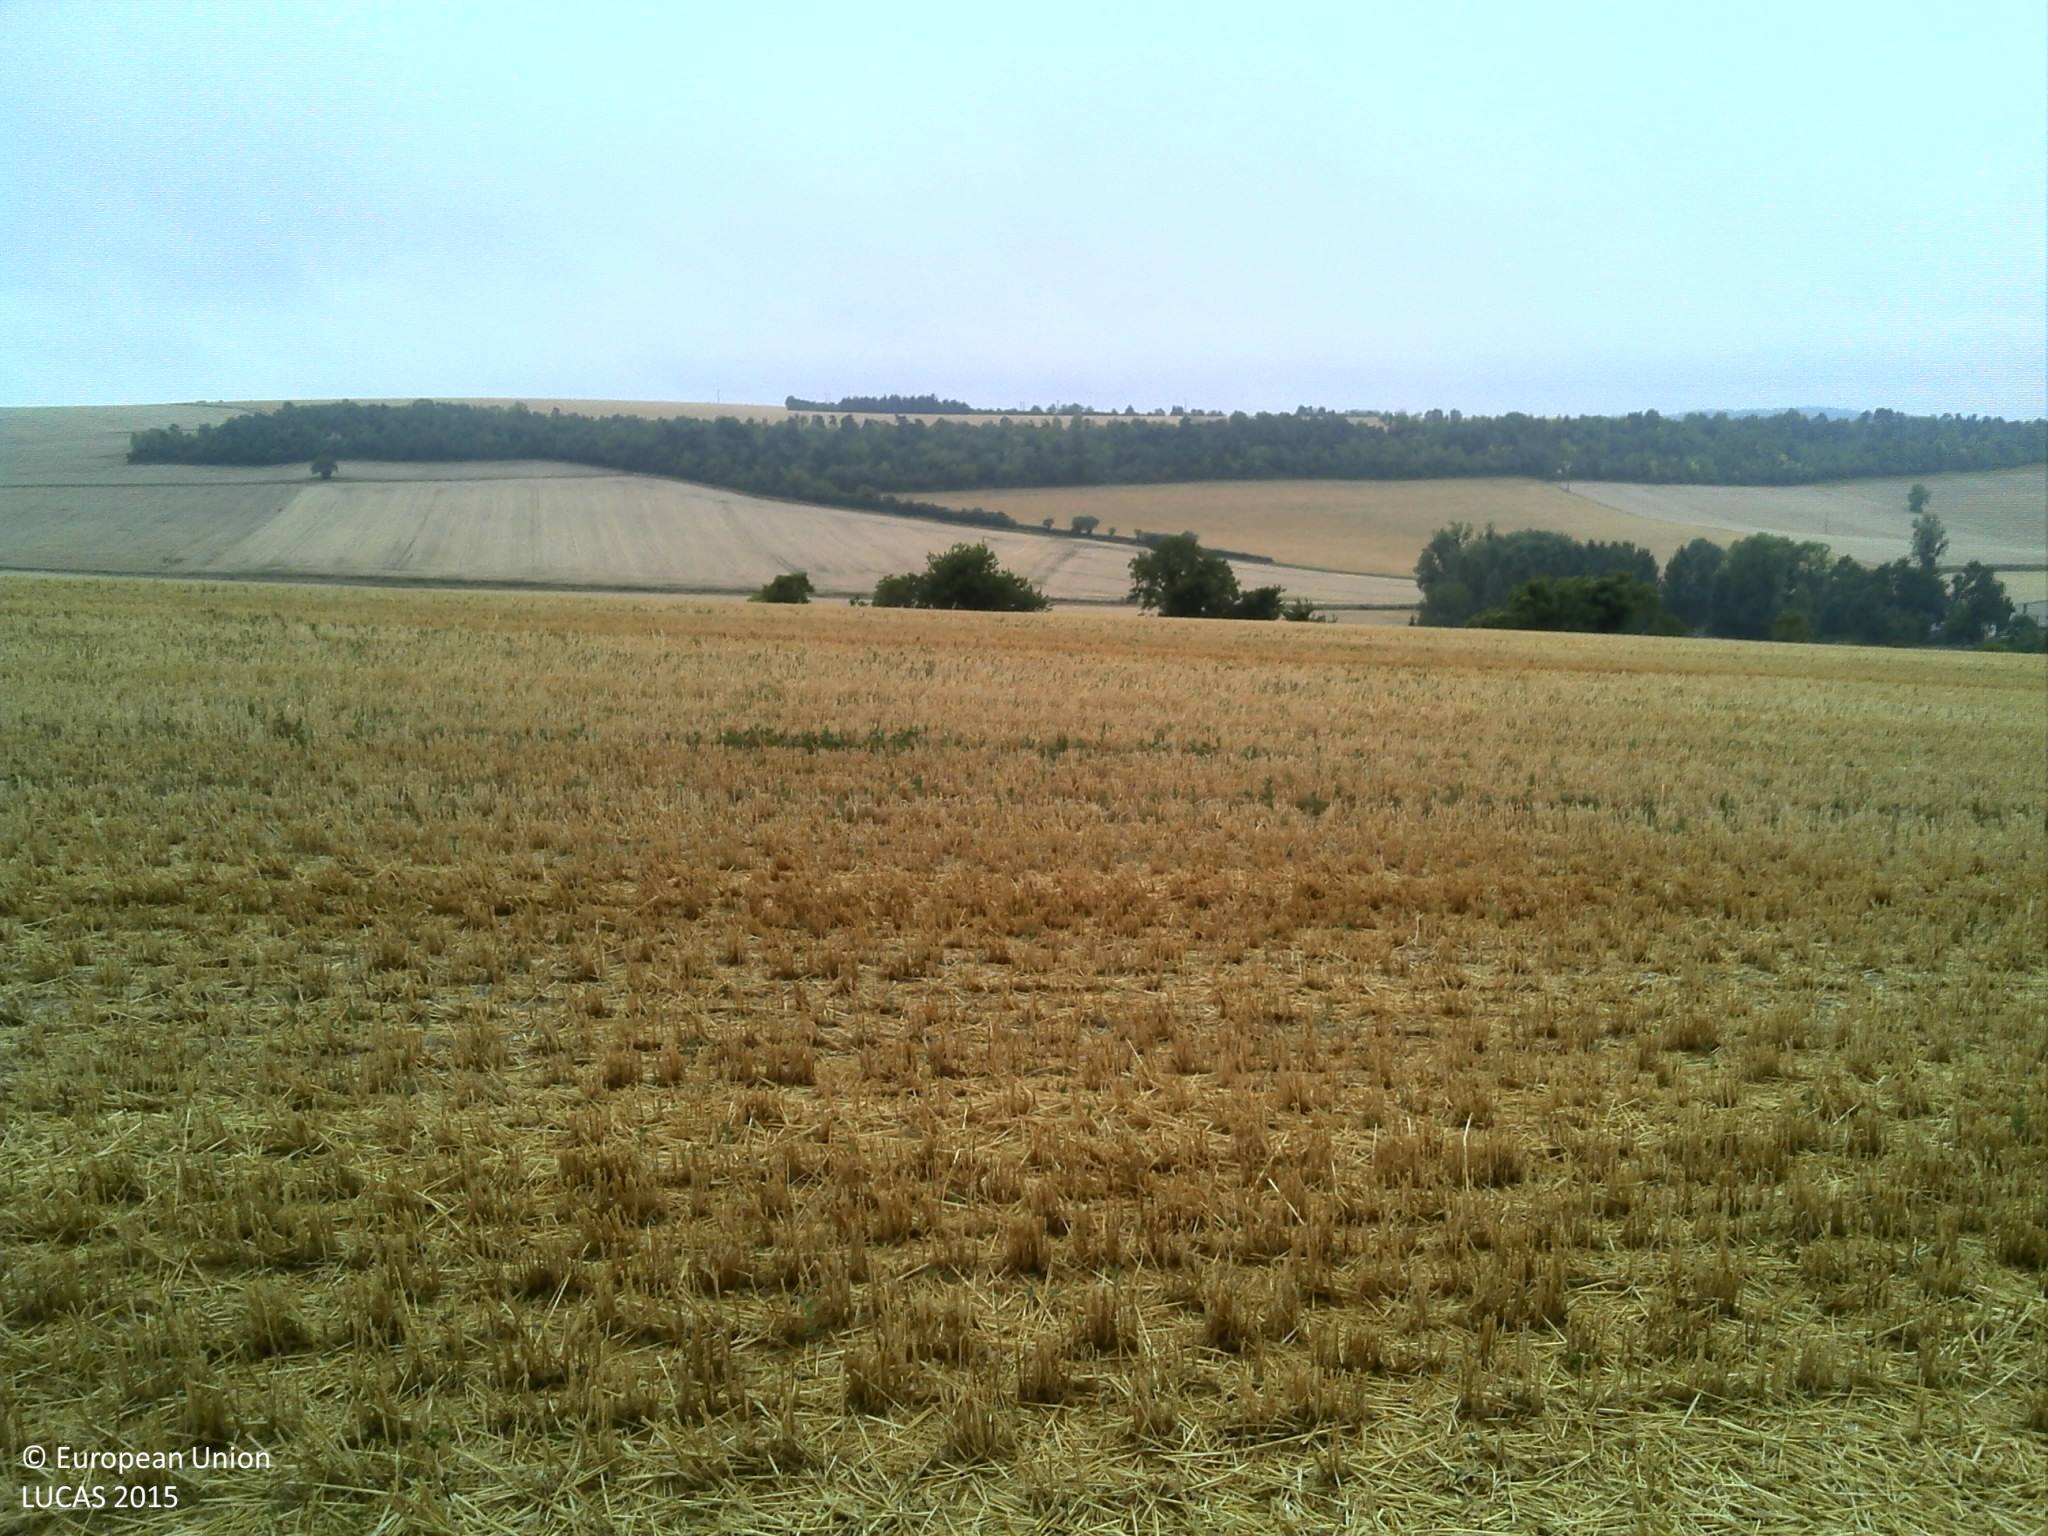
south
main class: Cropland
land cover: Barley
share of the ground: > 75 %
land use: Agriculture (excluding fallow land and kitchen gardens)
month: July
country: FR
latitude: 48.8352
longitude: 4.6976
